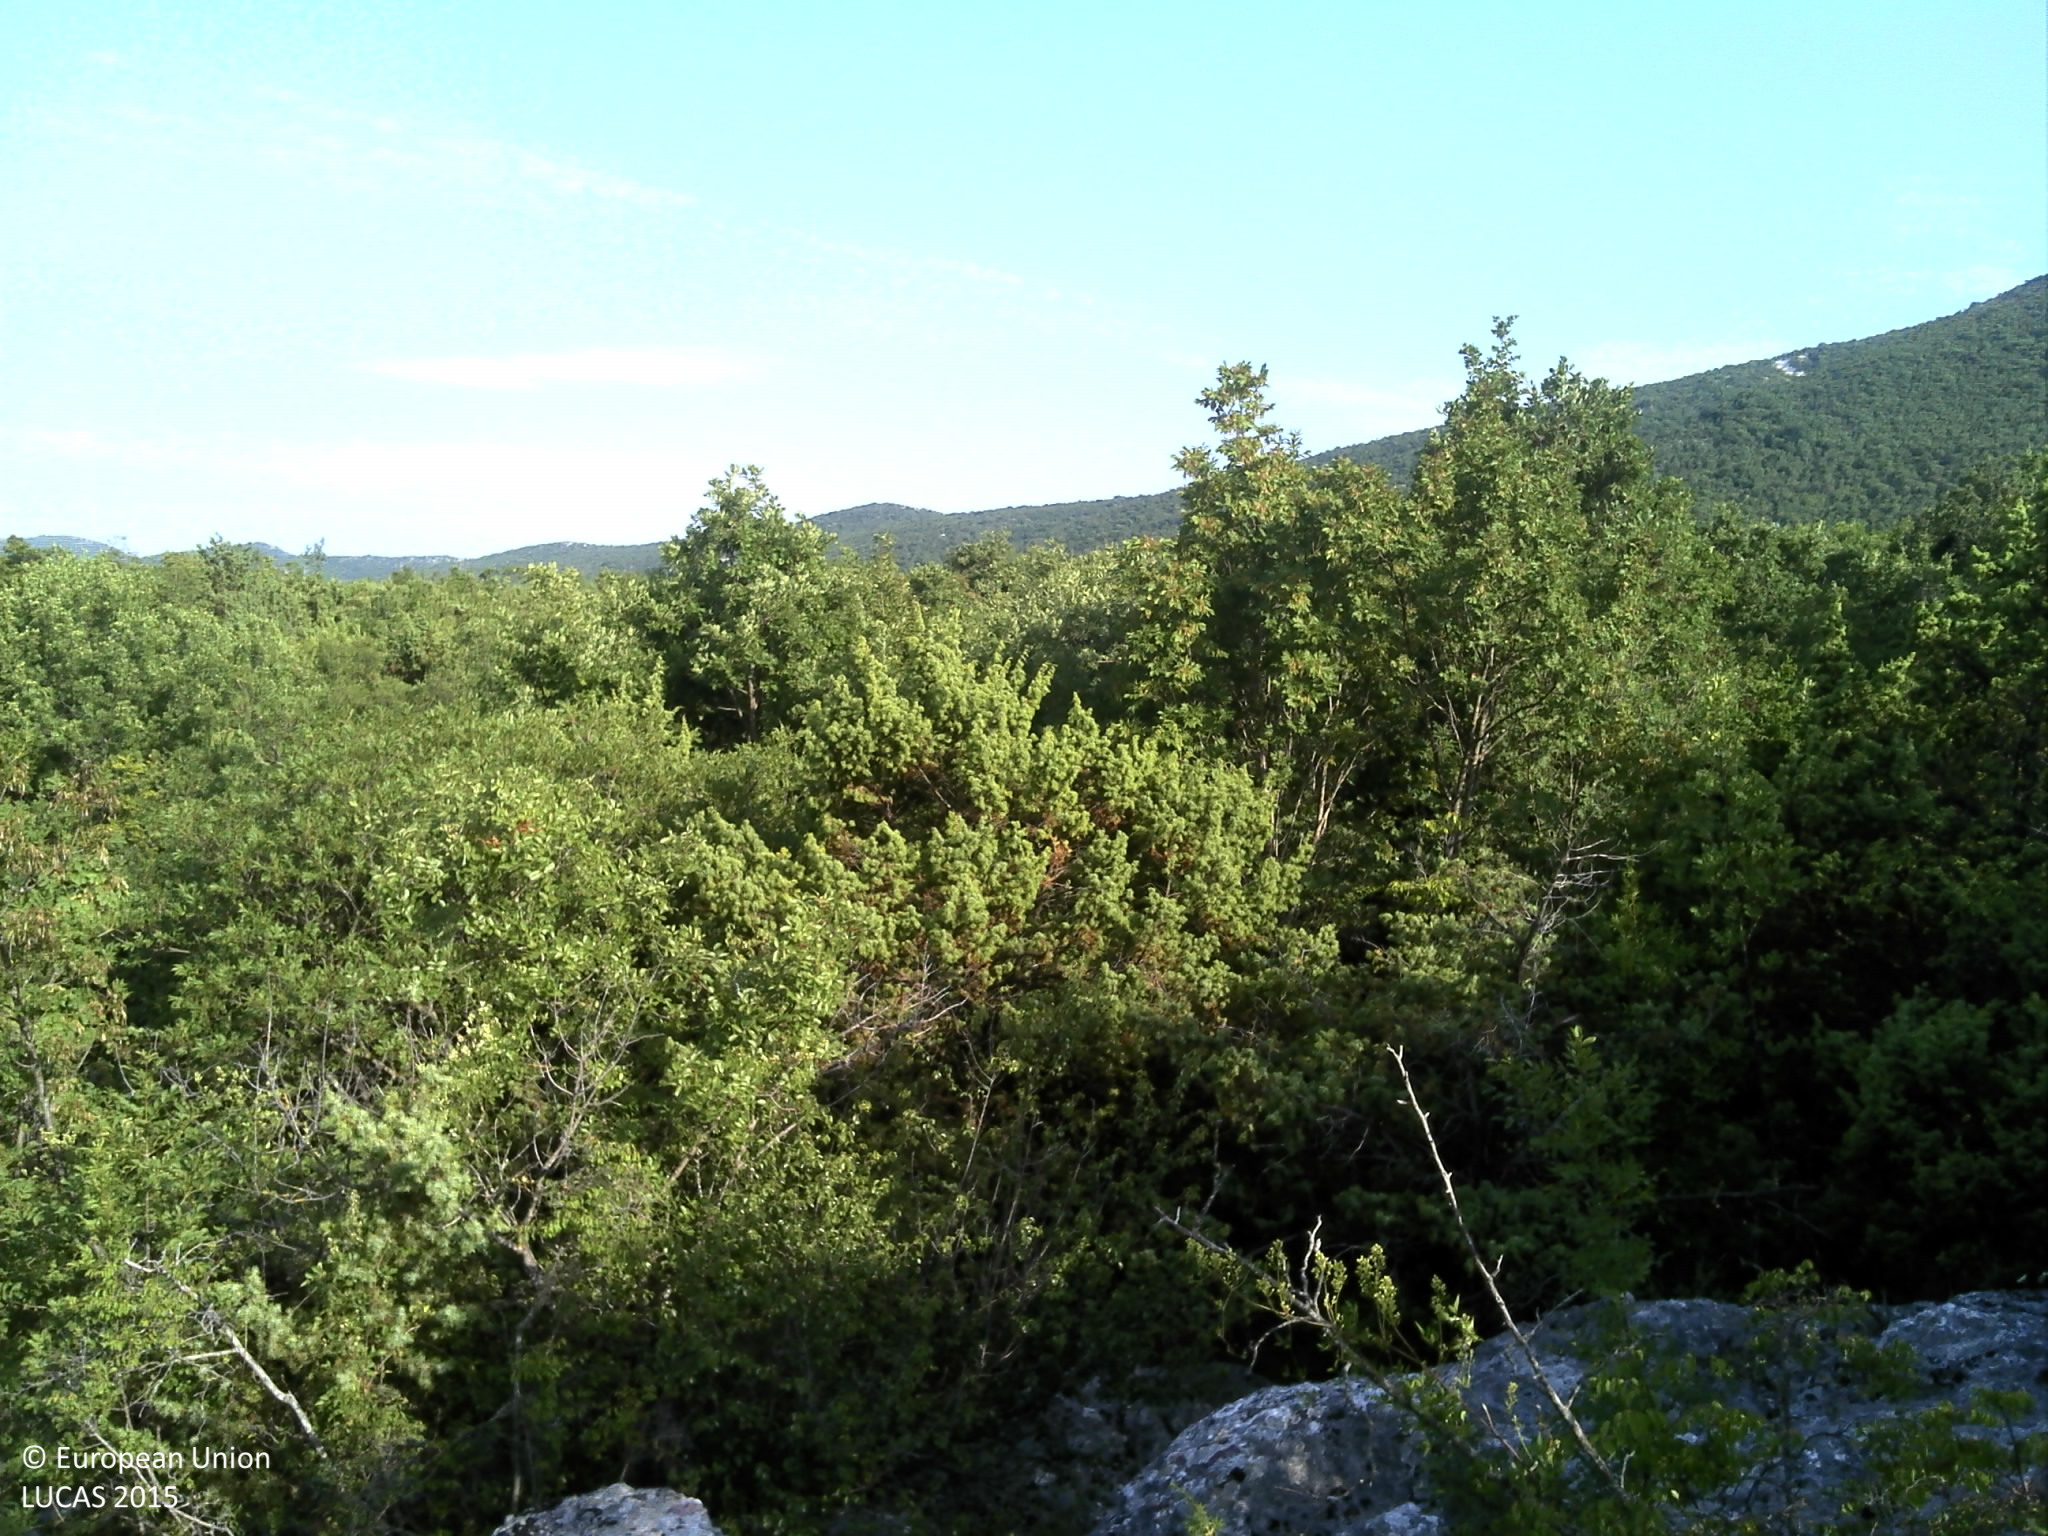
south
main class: Shrubland
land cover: Shrubland with sparse tree cover
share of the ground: > 75 %
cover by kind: shrubs 70 %, consolidated bare surface 15 %, unconsolidated bare surface 10 %, broadleaved forest trees 5 %
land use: Semi-natural and natural areas not in use
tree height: < 5 m
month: June
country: HR
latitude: 43.5985
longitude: 16.2963
